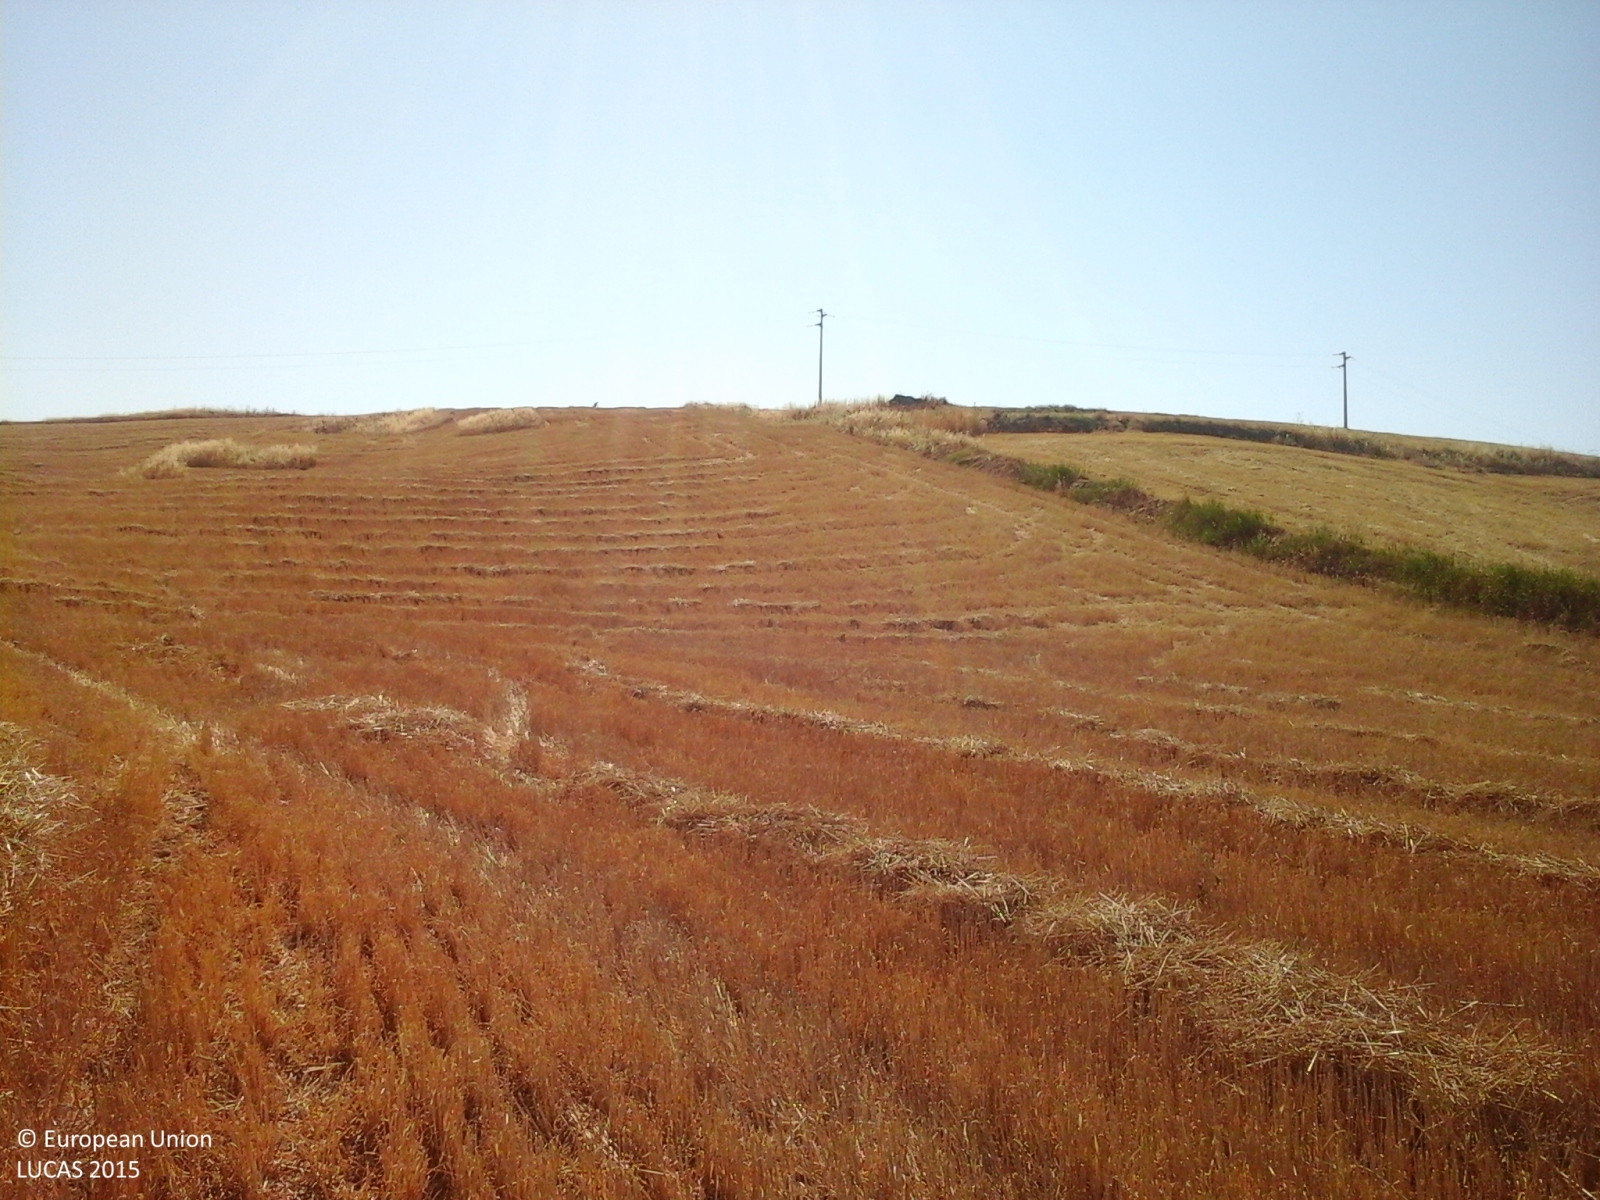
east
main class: Cropland
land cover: Durum wheat
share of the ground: > 75 %
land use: Agriculture (excluding fallow land and kitchen gardens)
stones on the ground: < 10 %
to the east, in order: Durum wheat; Electric lines; Grass margins; Tracks; Grass margins; Durum wheat
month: July
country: IT
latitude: 37.3541
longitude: 13.5512
